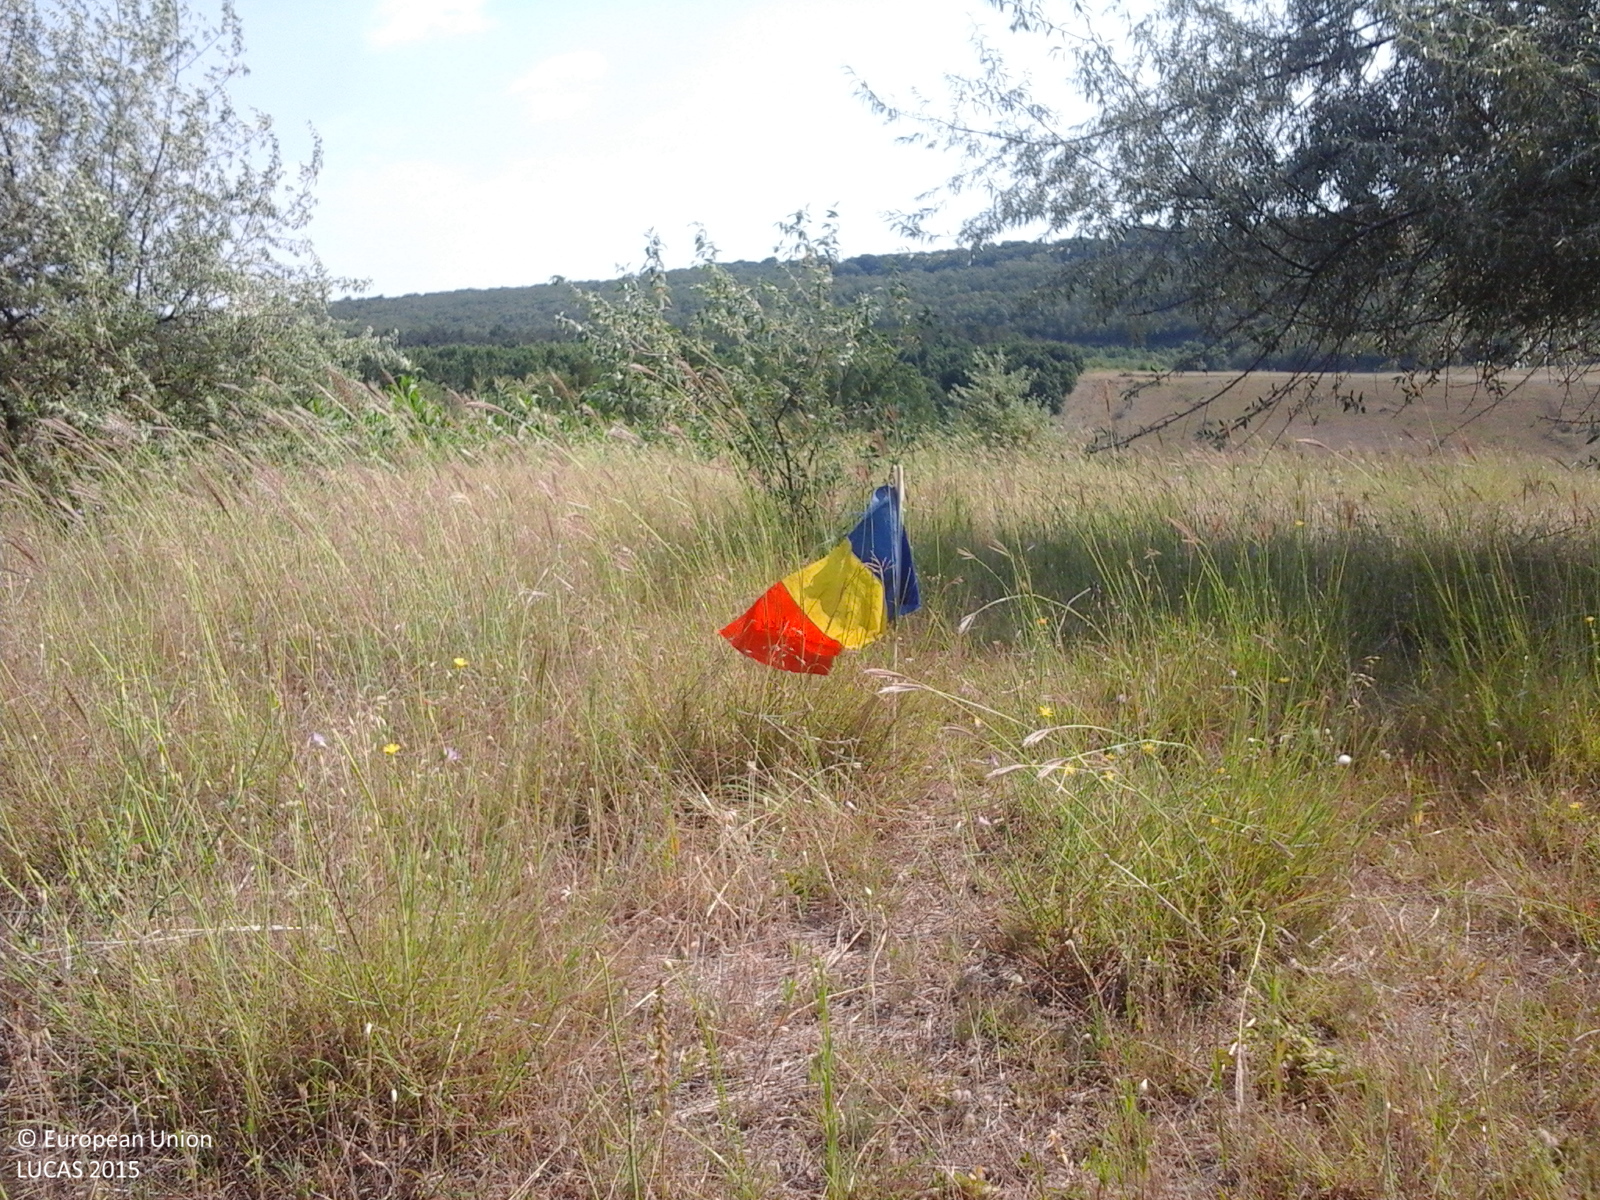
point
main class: Grassland
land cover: Grassland with sparse tree/shrub cover
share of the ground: > 75 %
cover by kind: herbaceous plants 95 %, broadleaved forest trees 5 %
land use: Agriculture (excluding fallow land and kitchen gardens)
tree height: > 5 m
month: July
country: RO
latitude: 46.0525
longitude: 27.8372
